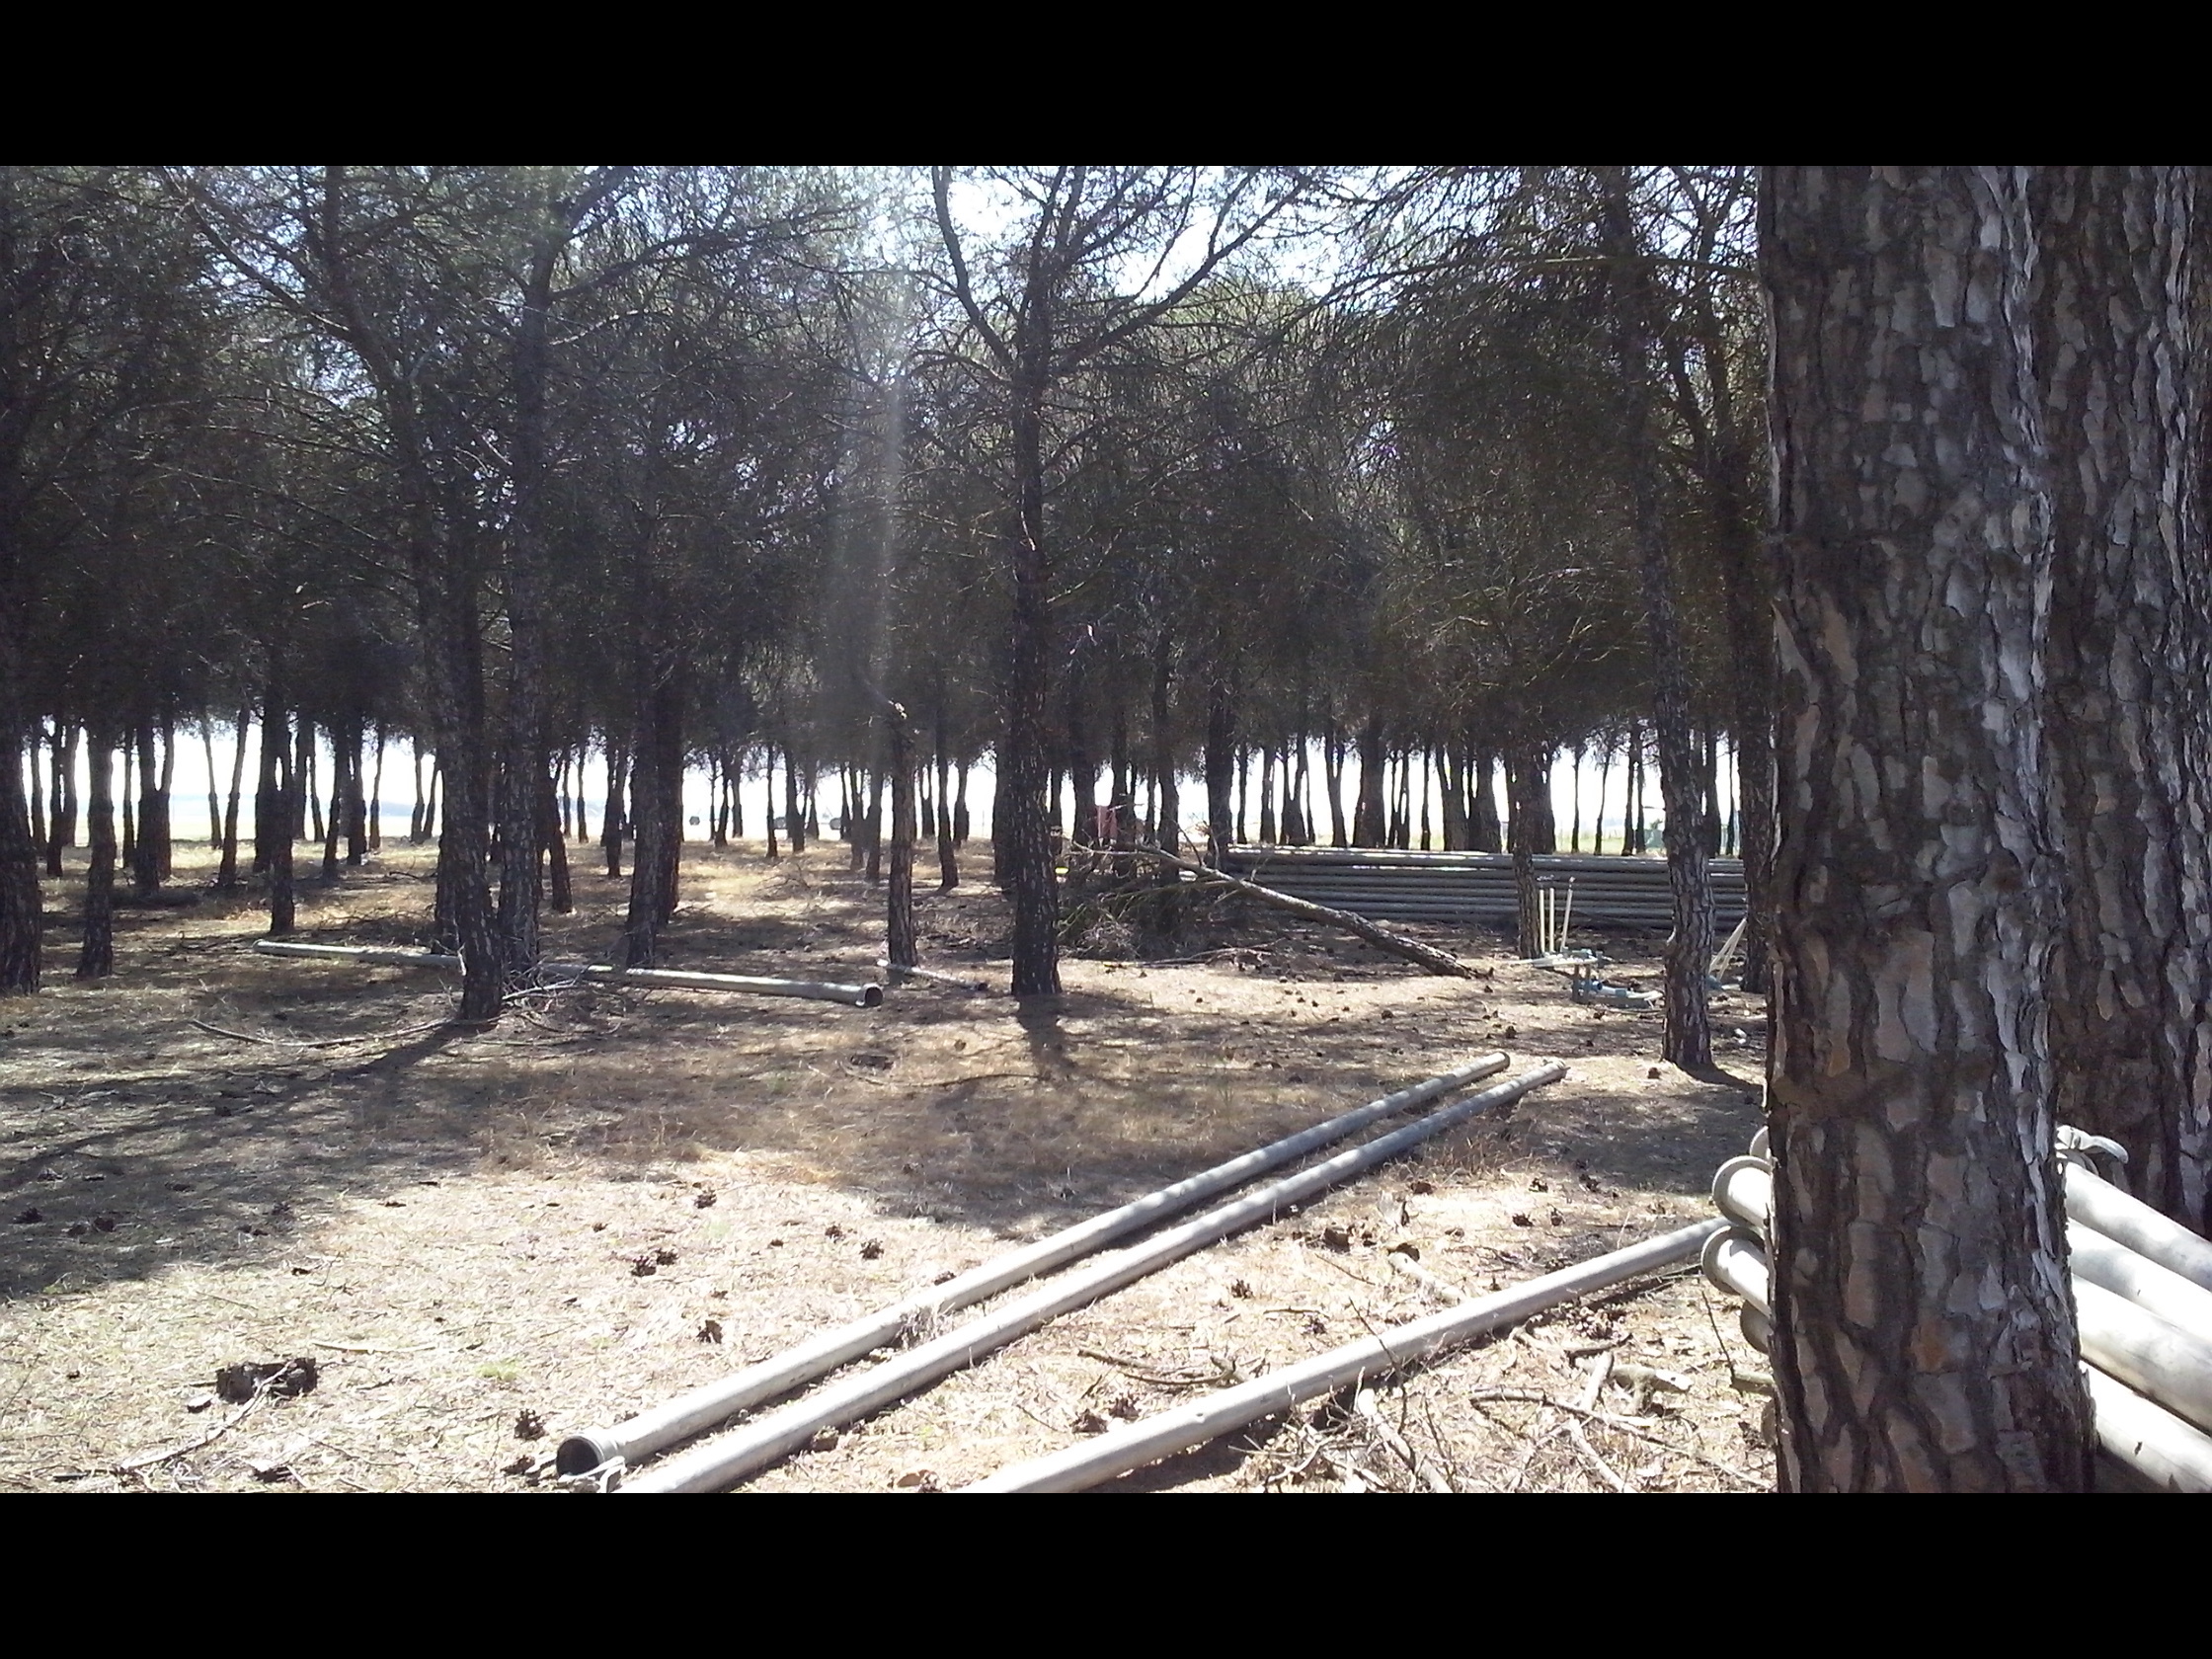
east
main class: Woodland
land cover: Pine dominated coniferous woodland
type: coniferous forest of the mediterranean region
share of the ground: 50 - 75 %
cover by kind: coniferous forest trees 60 %, herbaceous plants 25 %, unconsolidated bare surface 15 %
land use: Forestry
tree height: > 5 m
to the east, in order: Pine dominated coniferous woodland; Other bare soil; Other root crops
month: July
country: ES
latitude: 41.5163
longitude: -5.0879
